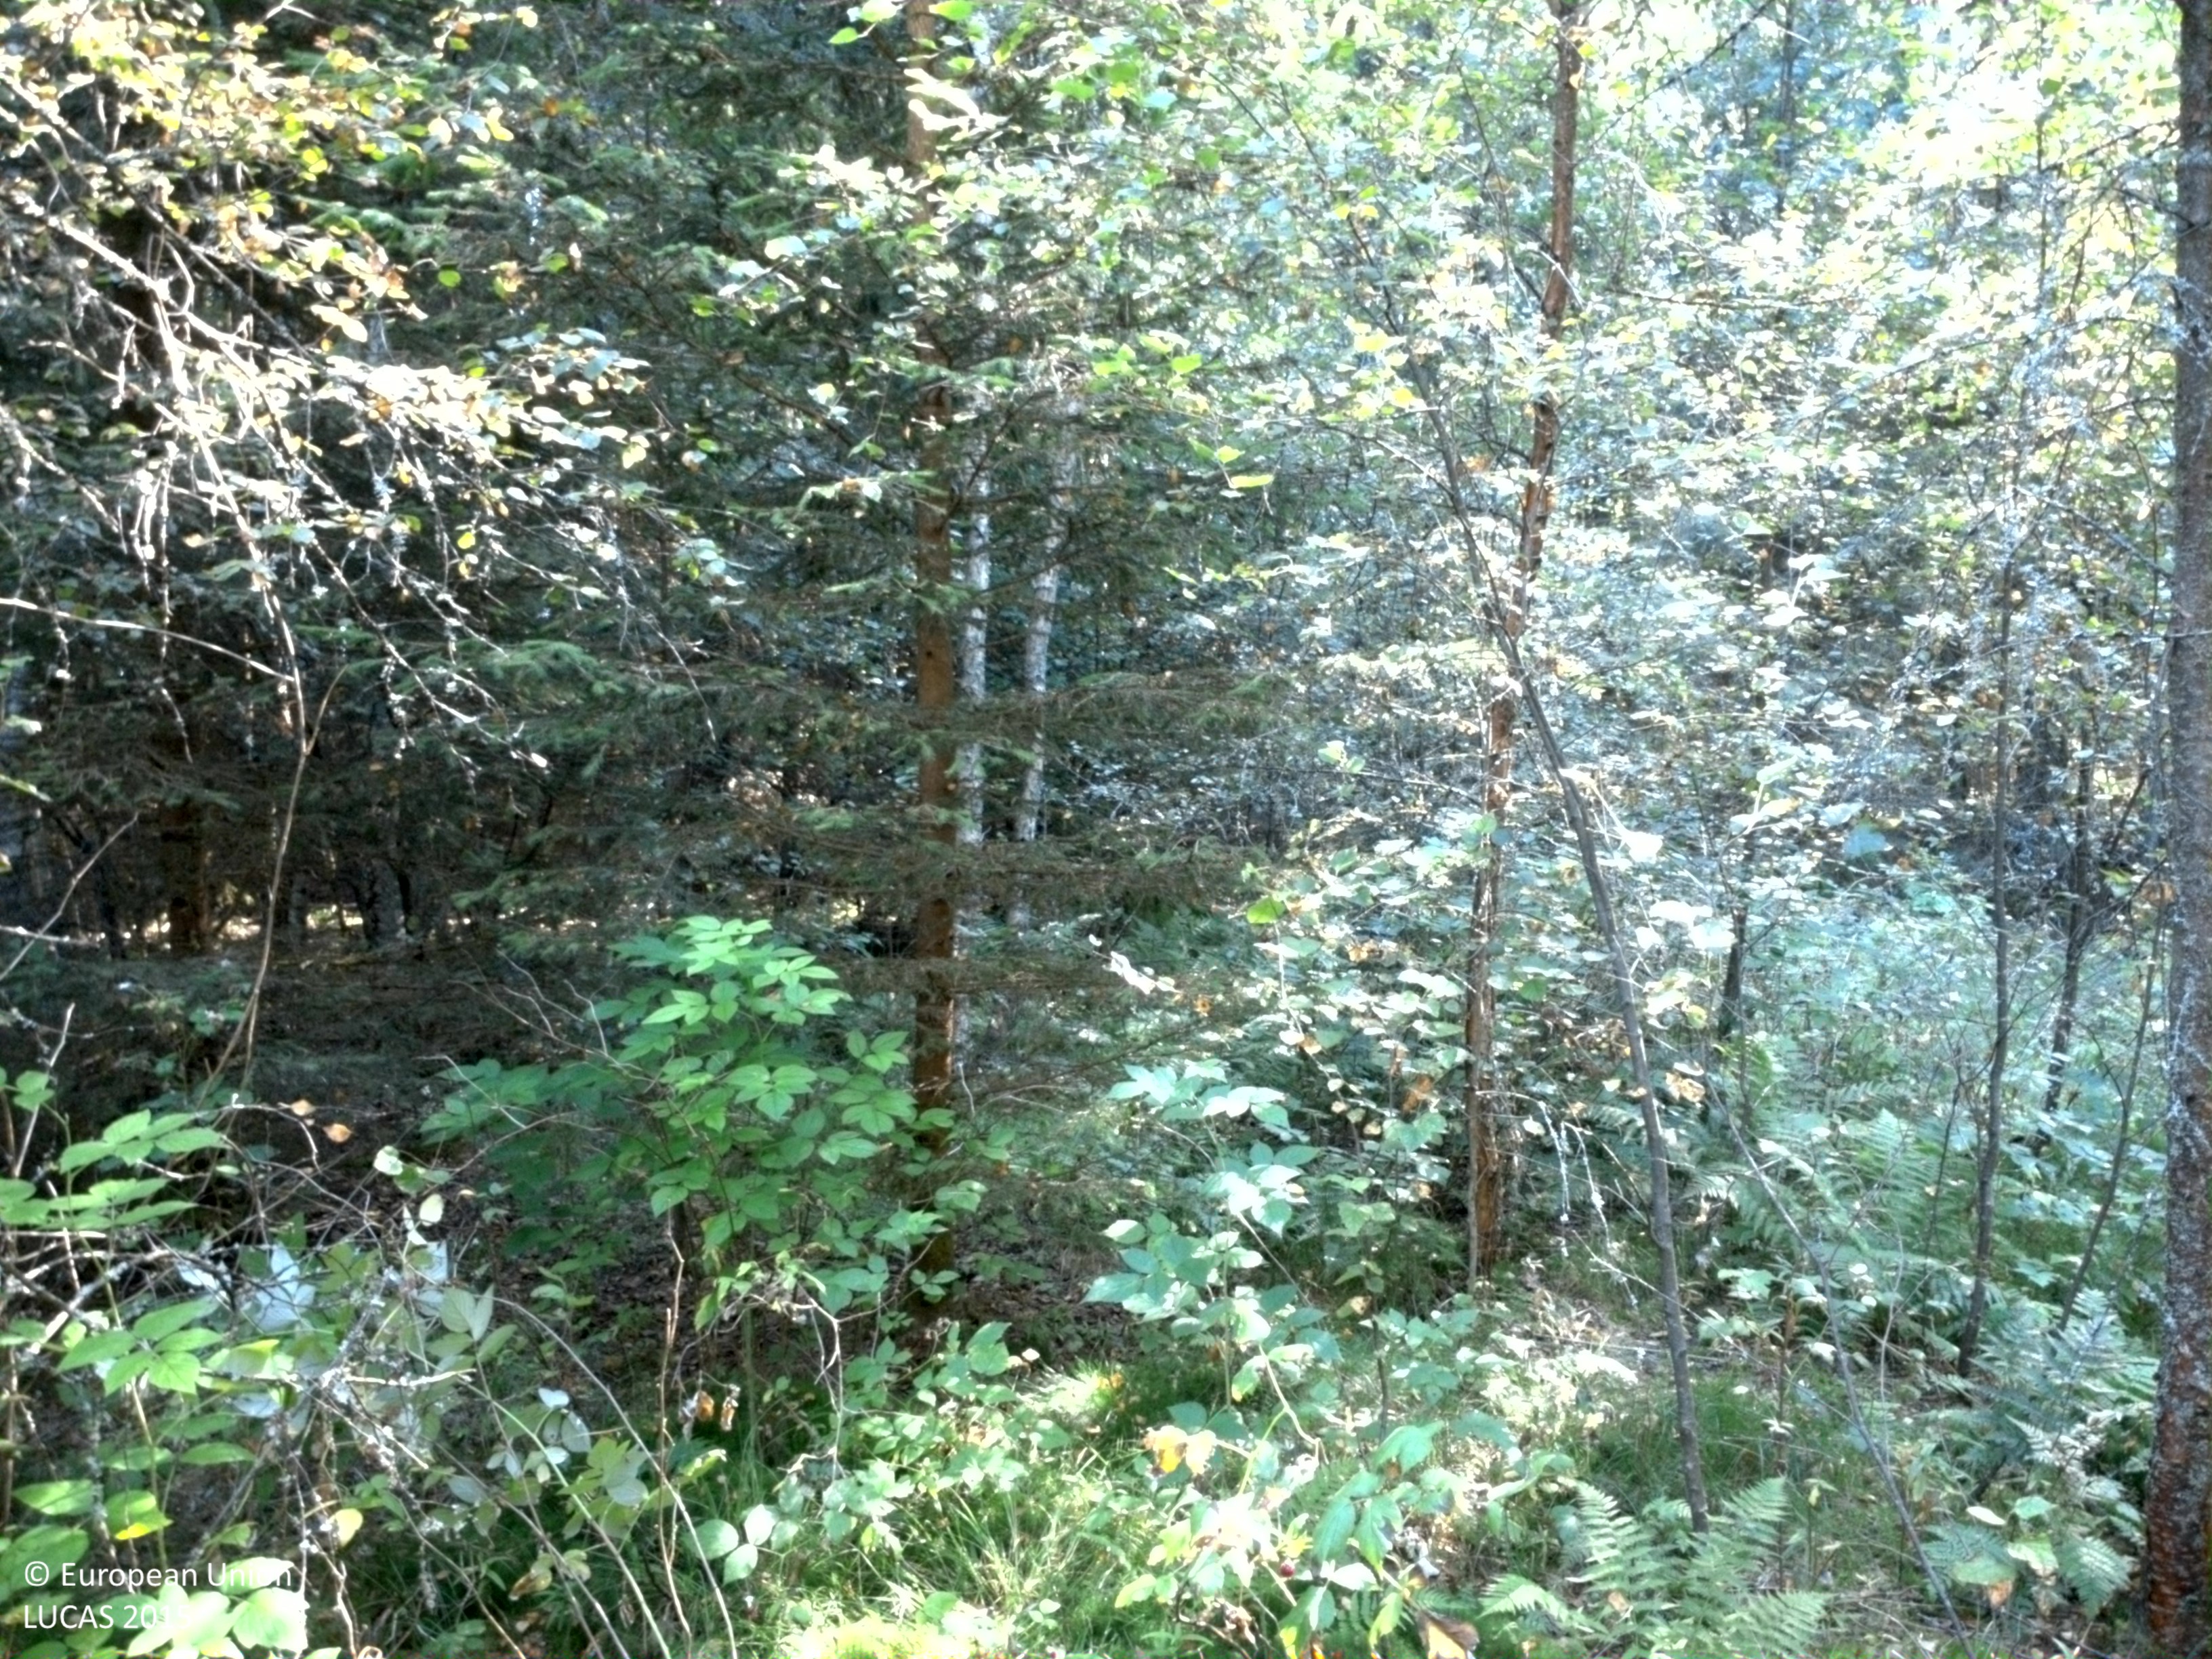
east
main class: Woodland
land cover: Broadleaved woodland
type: boreal forest
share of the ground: 25 - 50 %
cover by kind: broadleaved forest trees 45 %, shrubs 30 %, herbaceous plants 20 %, lichens and mosses 5 %
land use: Forestry
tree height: > 5 m
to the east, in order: Broadleaved woodland; Spruce dominated mixed woodland; Grassland without tree/shrub cover; Potatoes; Grassland without tree/shrub cover; Spontaneously vegetated surfaces; Spruce dominated mixed woodland; Potatoes; Other bare soil
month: August
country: SE
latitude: 59.4543
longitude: 13.4320
